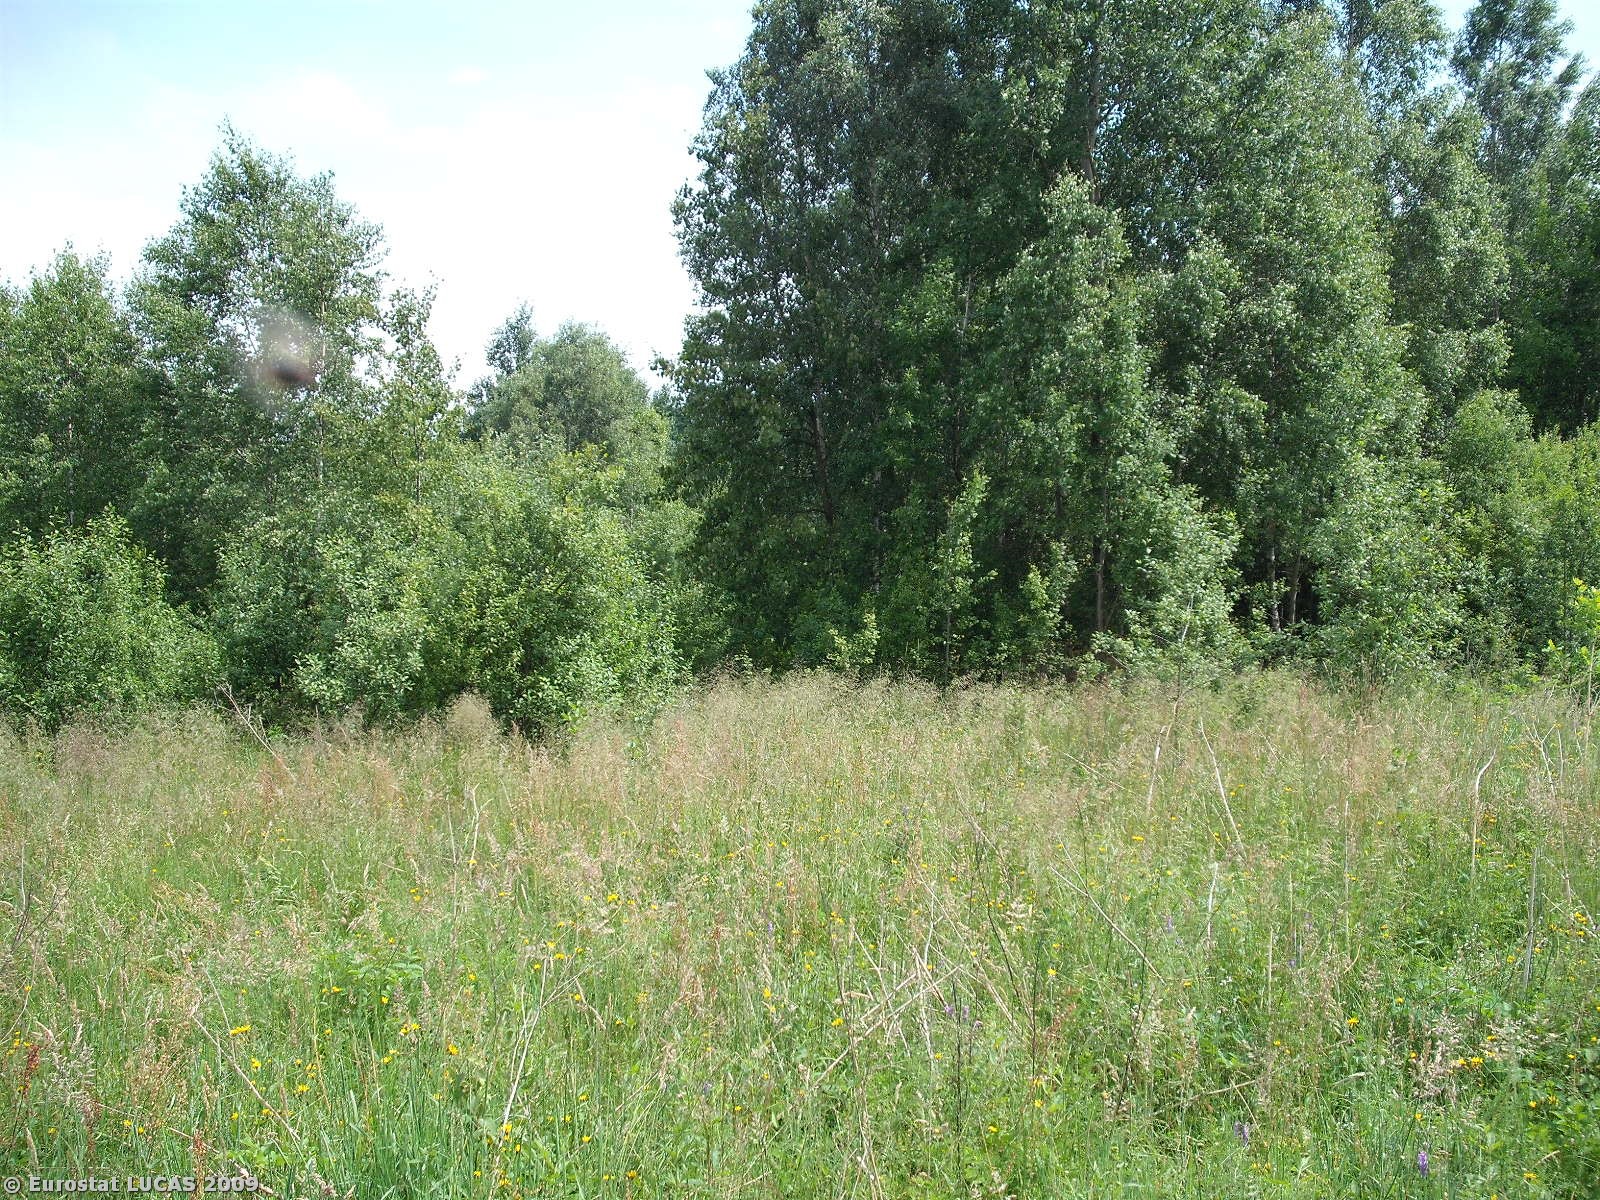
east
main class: Woodland
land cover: Broadleaved woodland
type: mesophytic deciduous forest
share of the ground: 25 - 50 %
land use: Unused
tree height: > 5 m
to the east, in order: Broadleaved woodland; Grassland with sparse tree/shrub cover
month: June
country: PL
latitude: 51.2513
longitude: 20.5699
